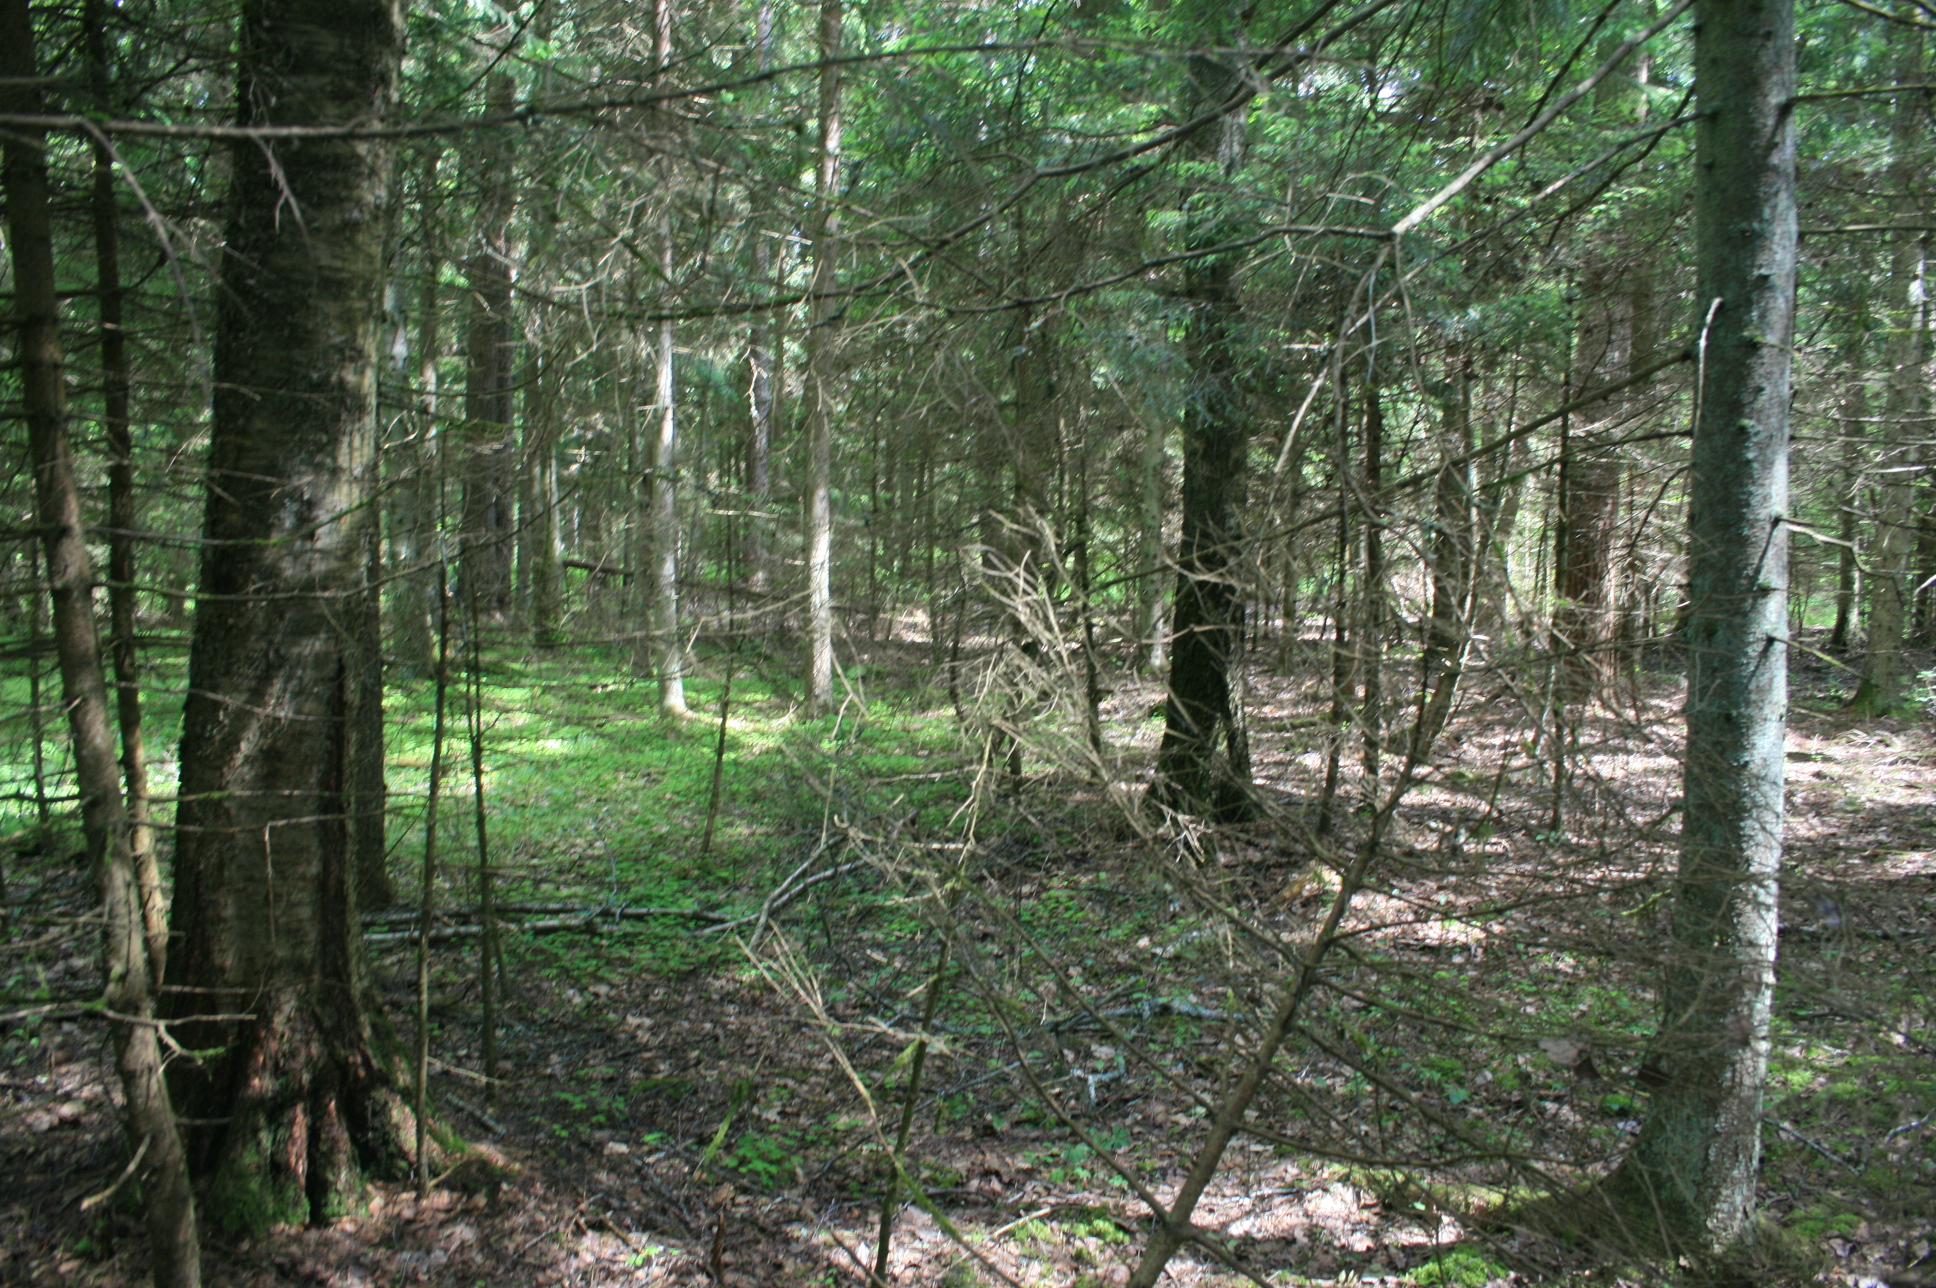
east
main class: Woodland
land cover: Spruce dominated mixed woodland
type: hemiboreal forest and nemoral coniferous forest and mixed broadleaved-coniferous forest
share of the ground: > 75 %
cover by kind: broadleaved forest trees 50 %, coniferous forest trees 40 %, herbaceous plants 10 %
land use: Forestry
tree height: > 5 m
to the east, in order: Spruce dominated mixed woodland
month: June
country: LT
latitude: 55.2996
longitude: 22.1366
